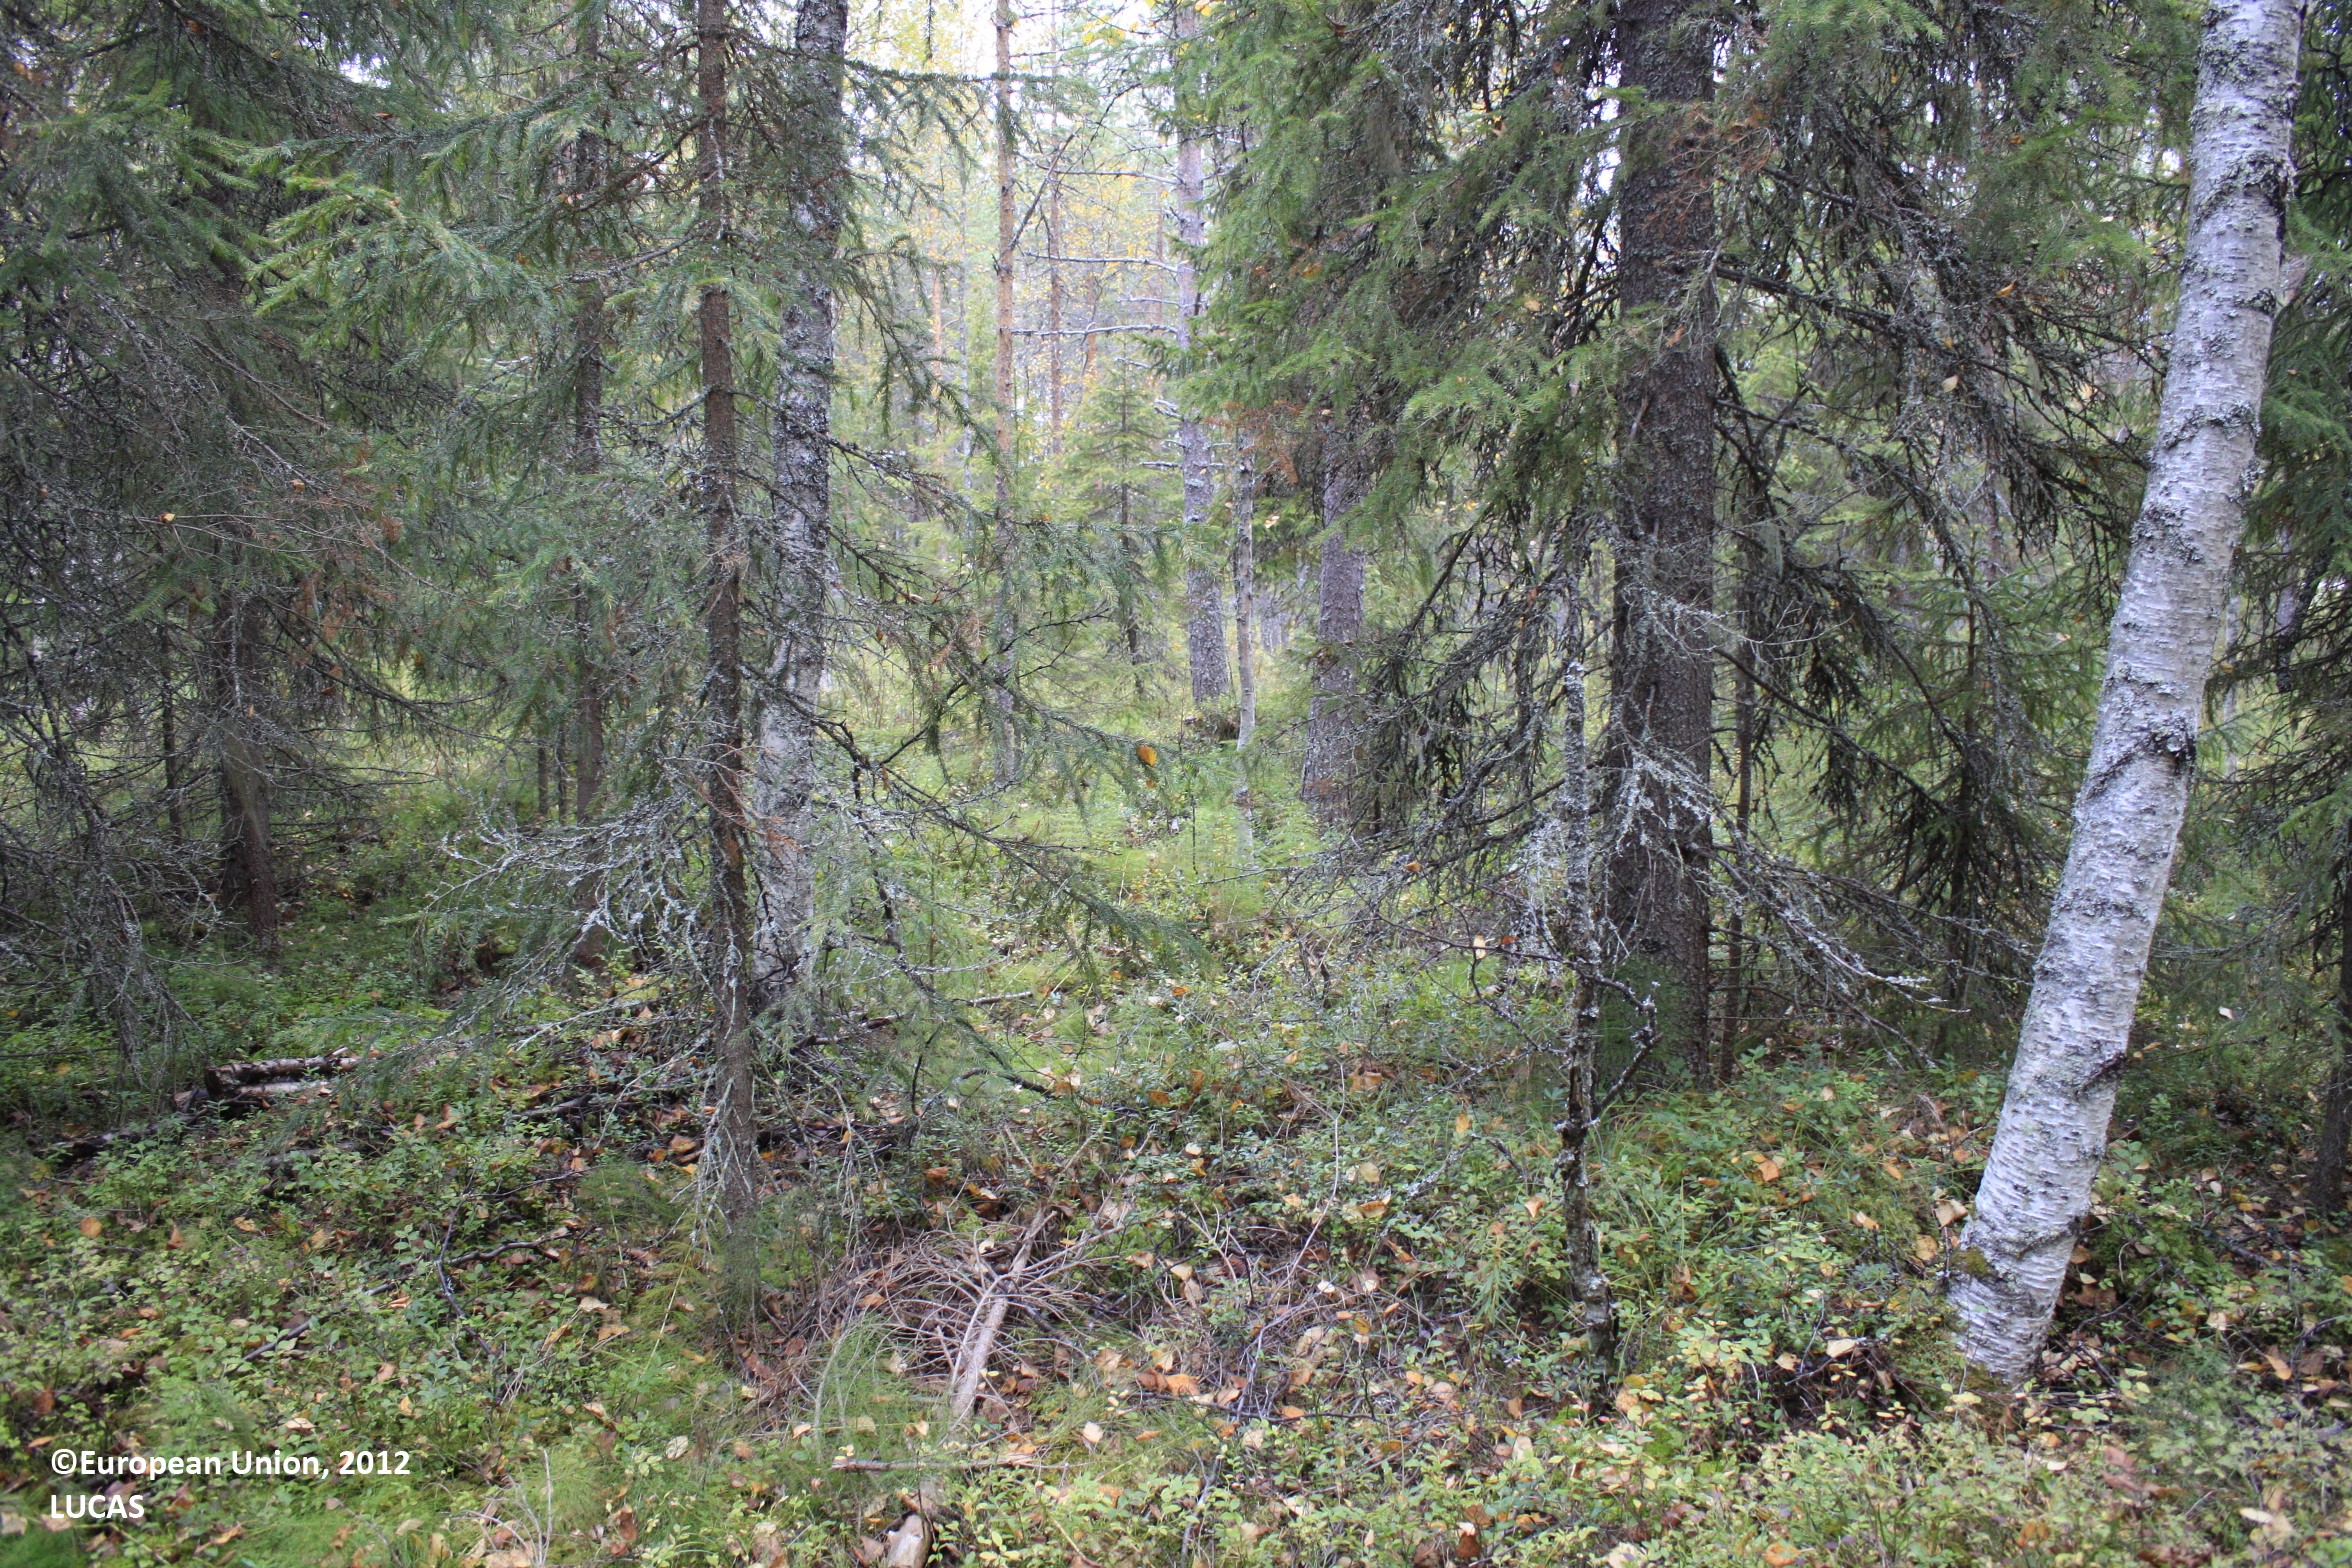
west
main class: Woodland
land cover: Spruce dominated mixed woodland
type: boreal forest
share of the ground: 50 - 75 %
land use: Forestry
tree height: > 5 m
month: September
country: FI
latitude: 65.7018
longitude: 27.3494
